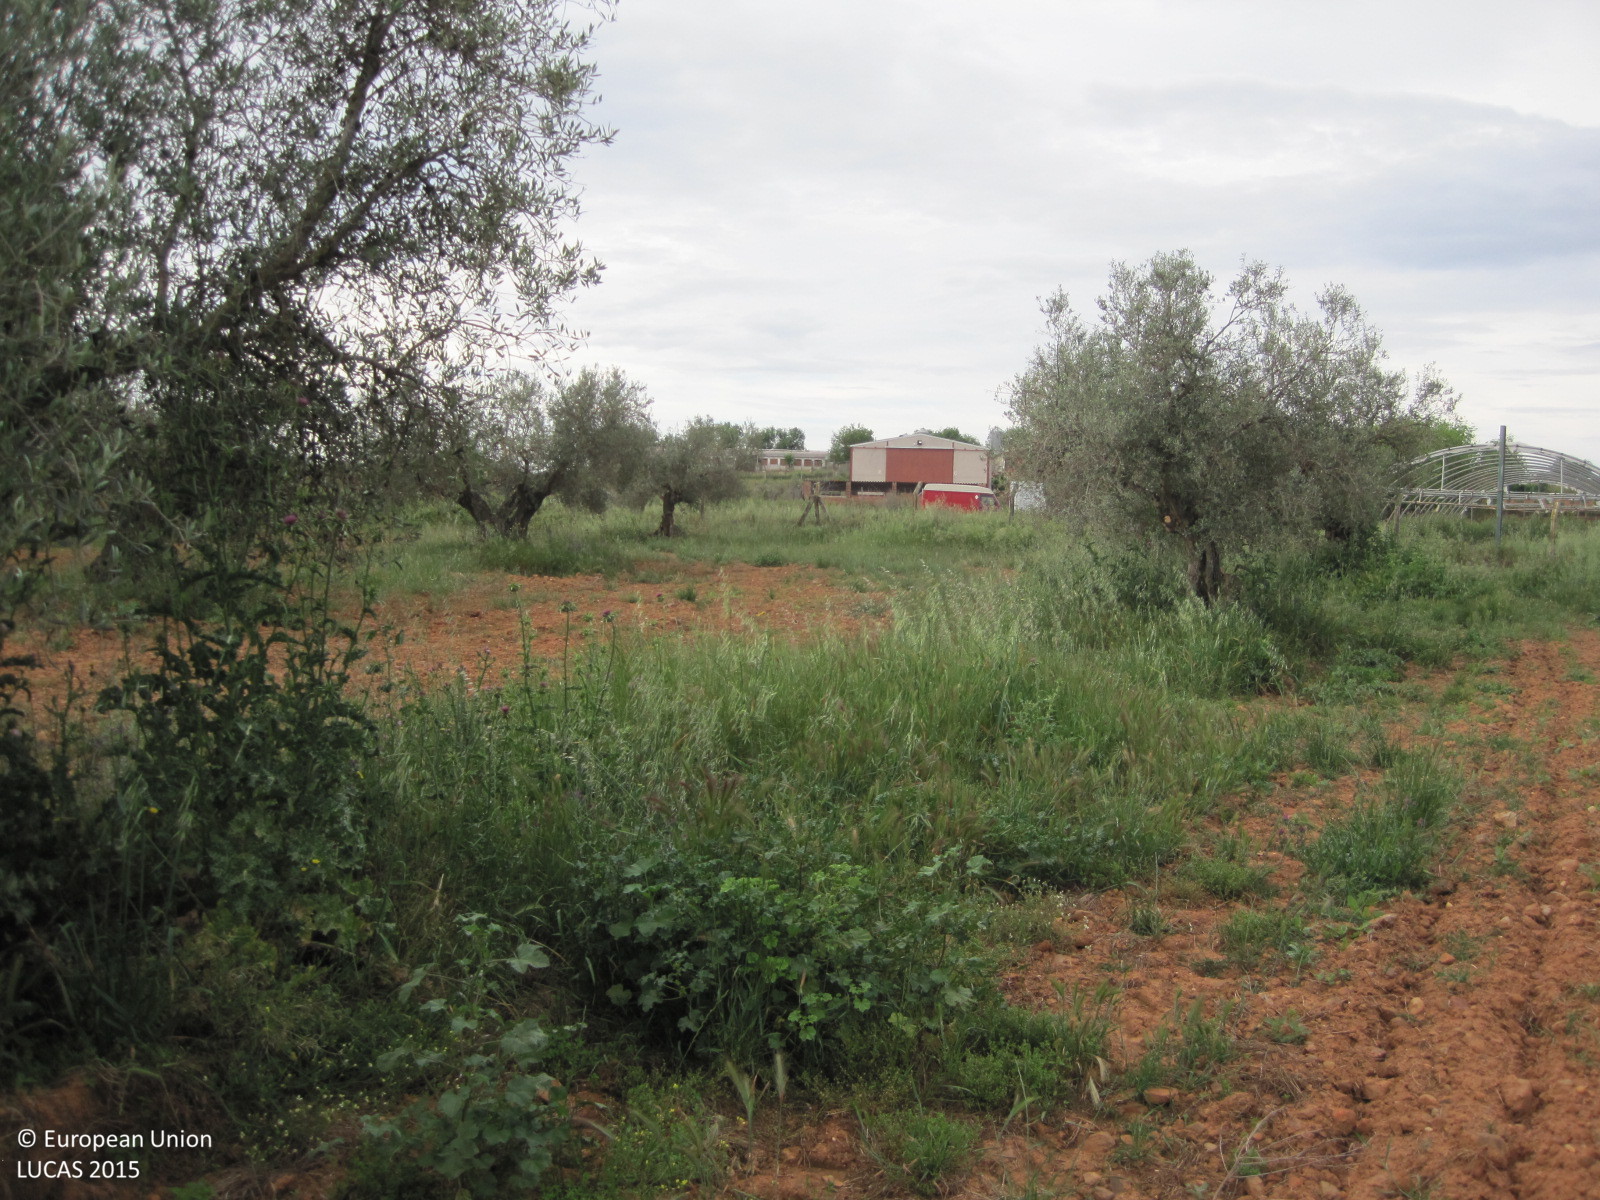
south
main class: Cropland
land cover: Barley
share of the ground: > 75 %
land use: Agriculture (excluding fallow land and kitchen gardens)
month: May
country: ES
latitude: 39.8879
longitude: -4.6974
